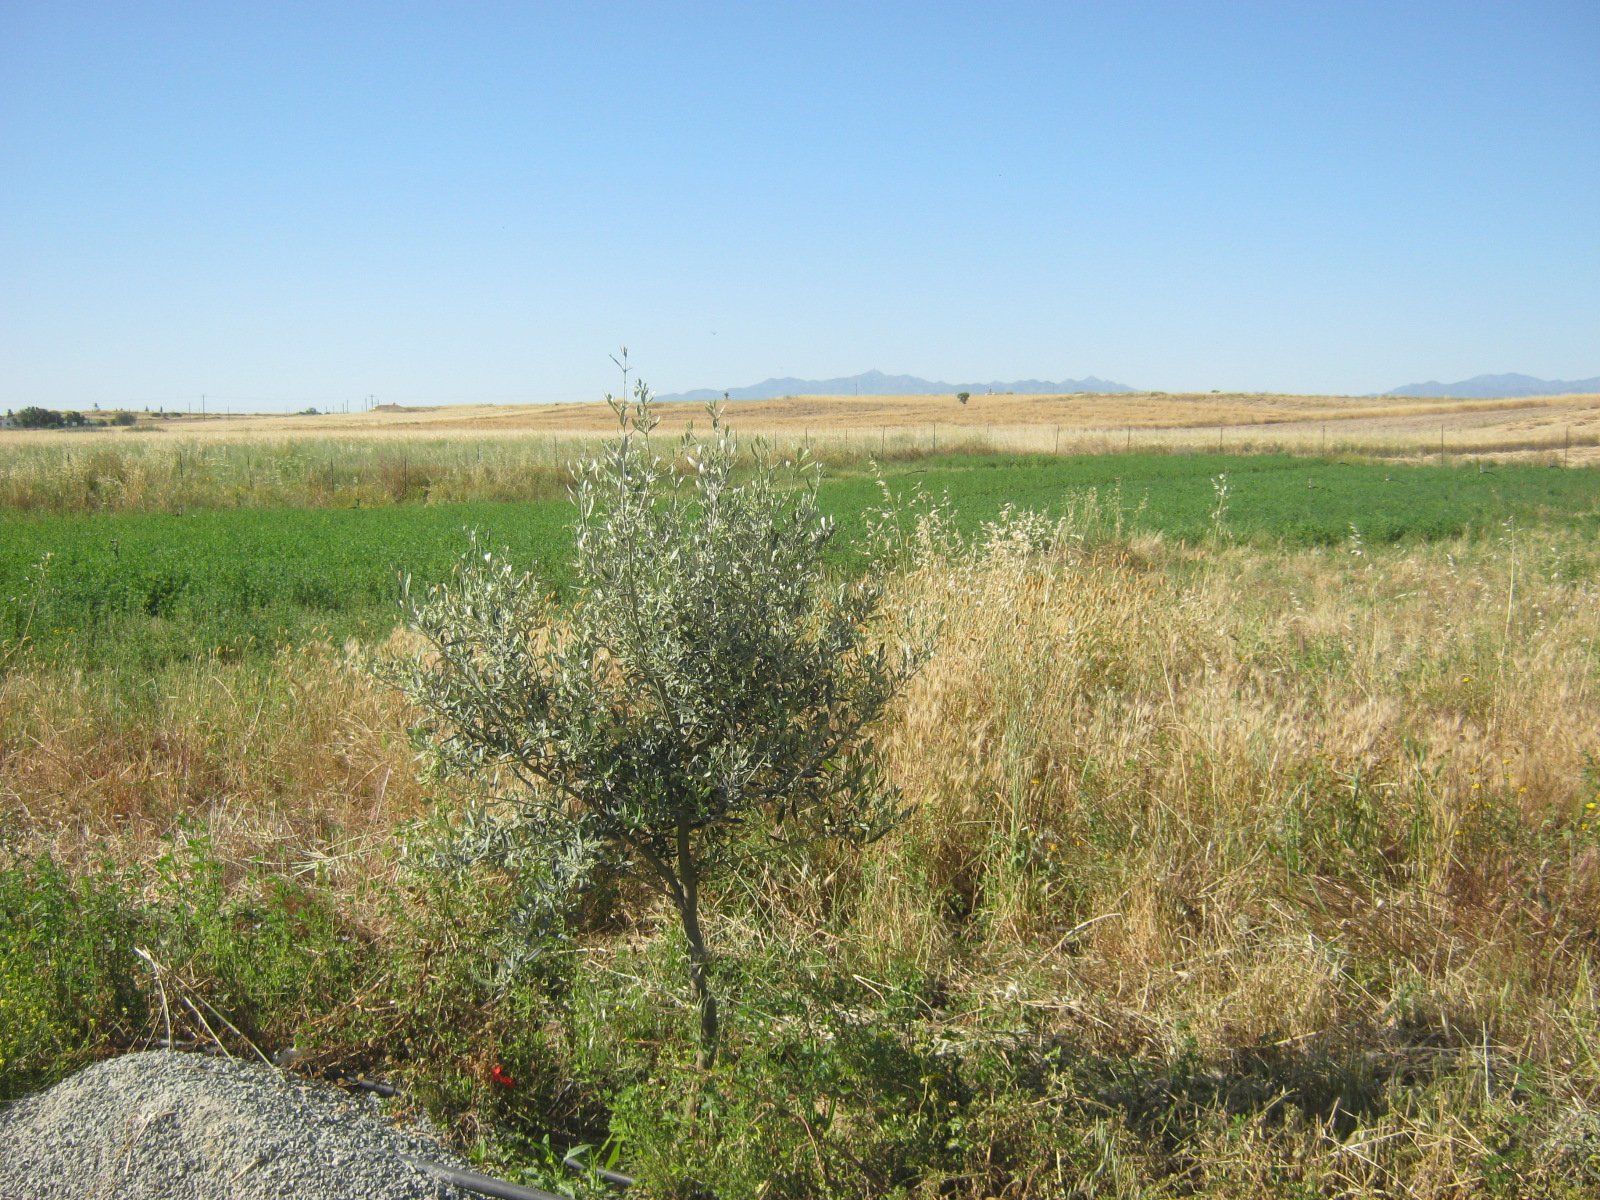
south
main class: Grassland
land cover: Spontaneously vegetated surfaces
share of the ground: > 75 %
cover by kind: herbaceous plants 90 %, unconsolidated bare surface 10 %
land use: Agriculture (excluding fallow land and kitchen gardens)
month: May
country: CY
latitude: 35.1601
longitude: 33.2545
